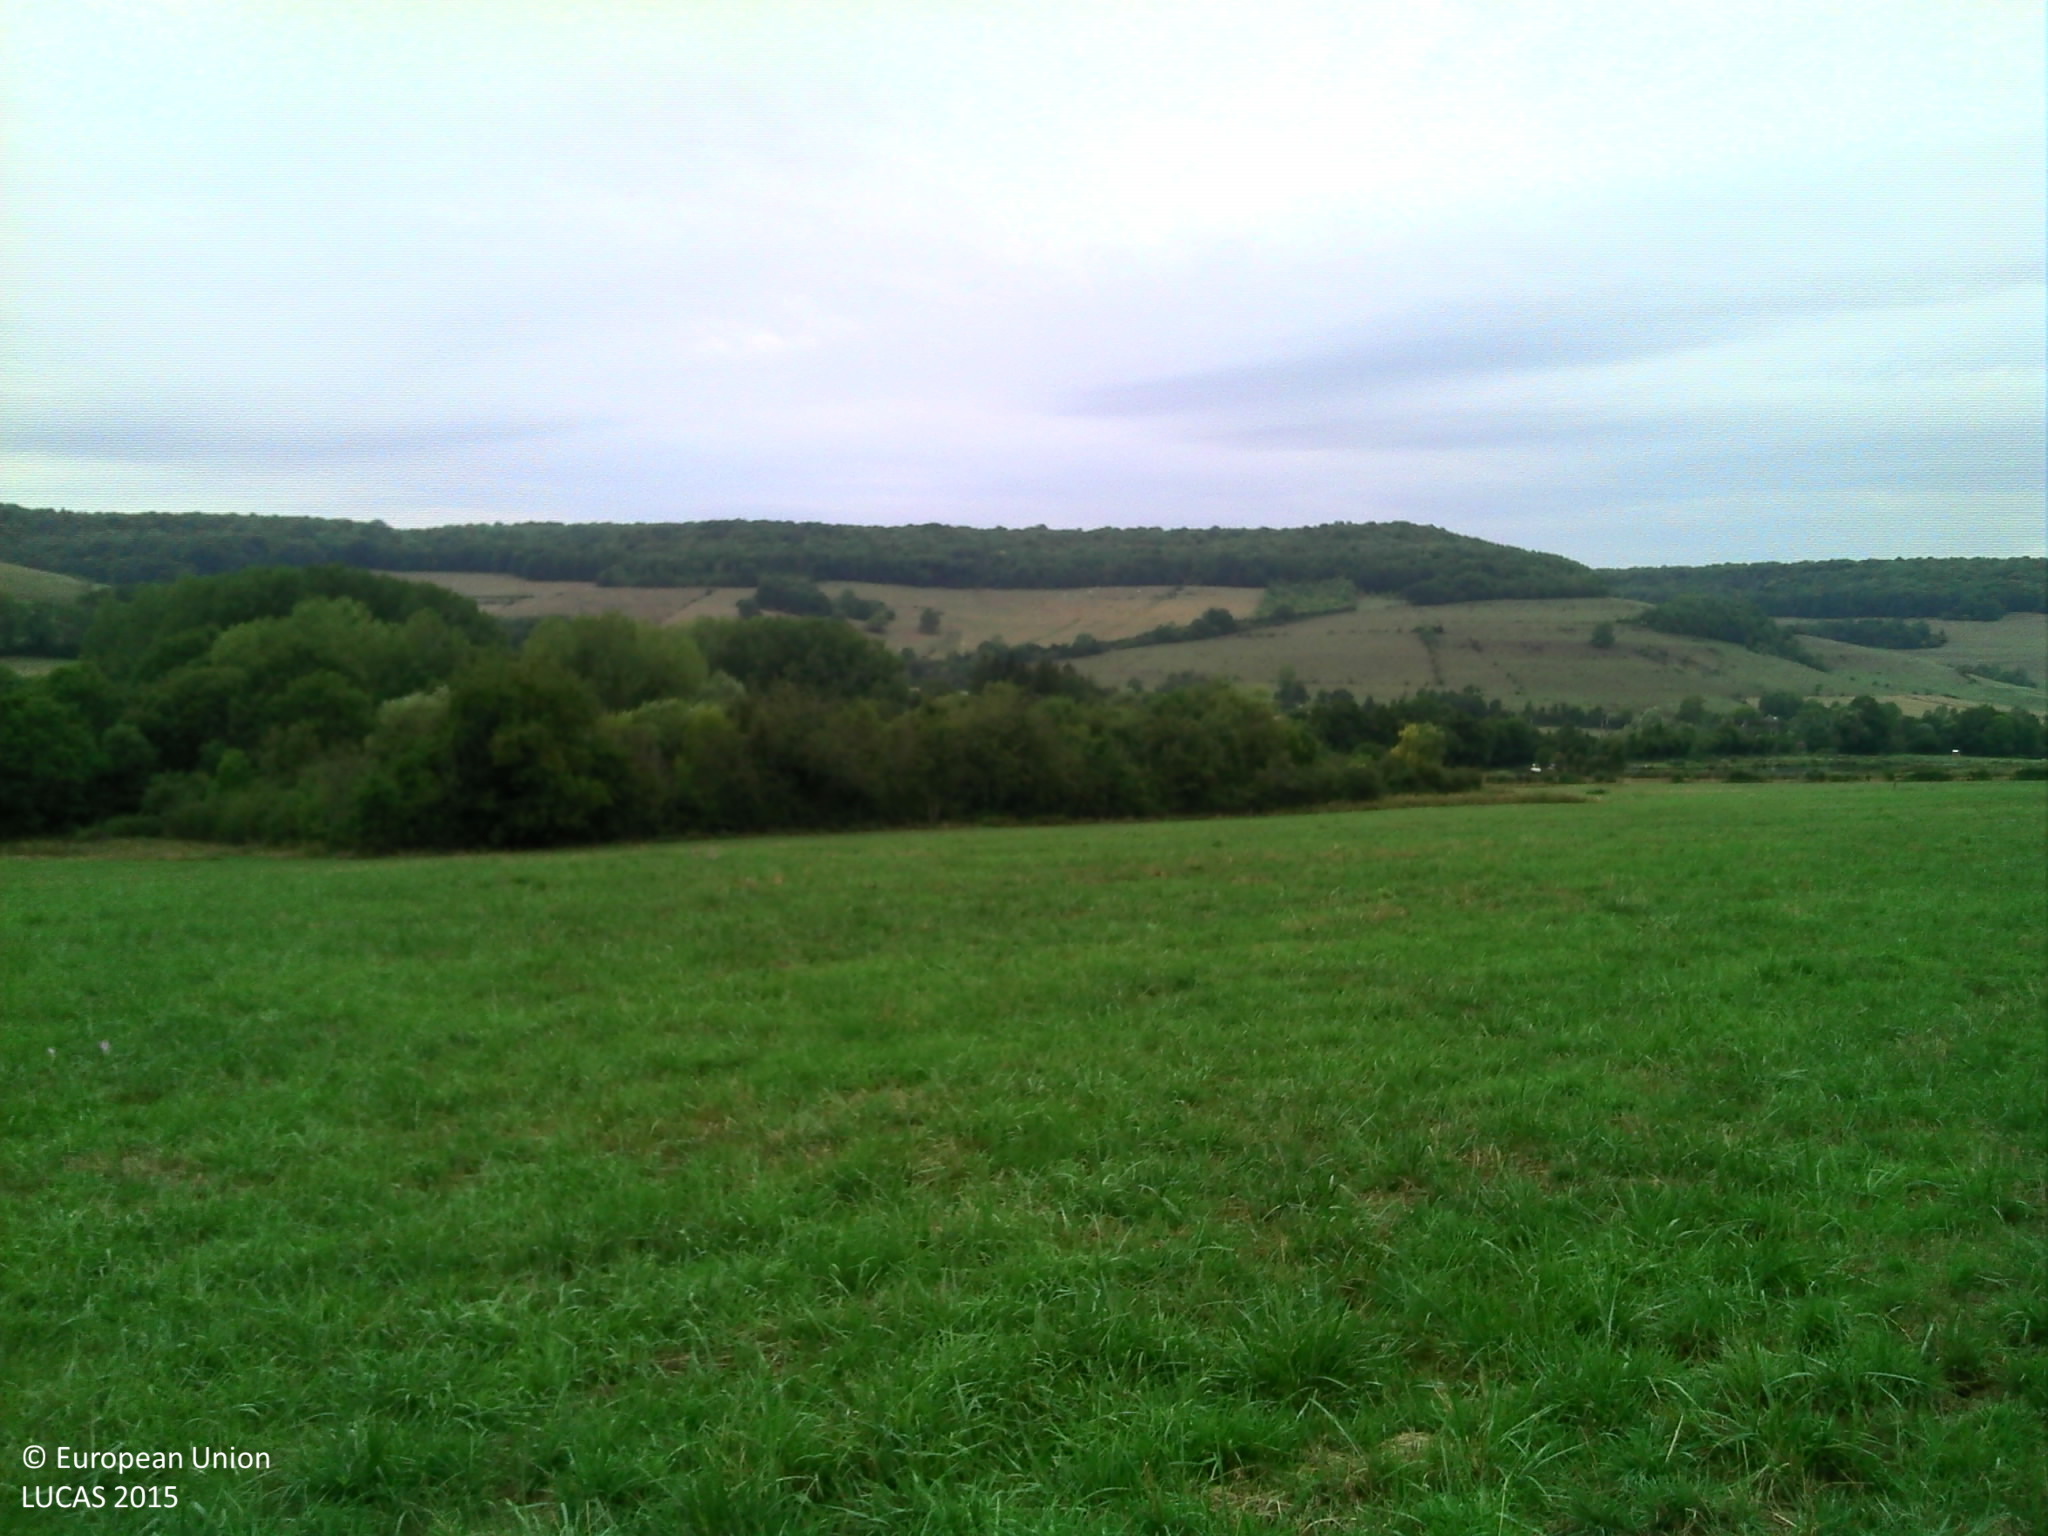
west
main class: Grassland
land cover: Grassland without tree/shrub cover
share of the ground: > 75 %
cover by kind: herbaceous plants 100 %
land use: Agriculture (excluding fallow land and kitchen gardens)
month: August
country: FR
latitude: 47.3767
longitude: 4.7419
